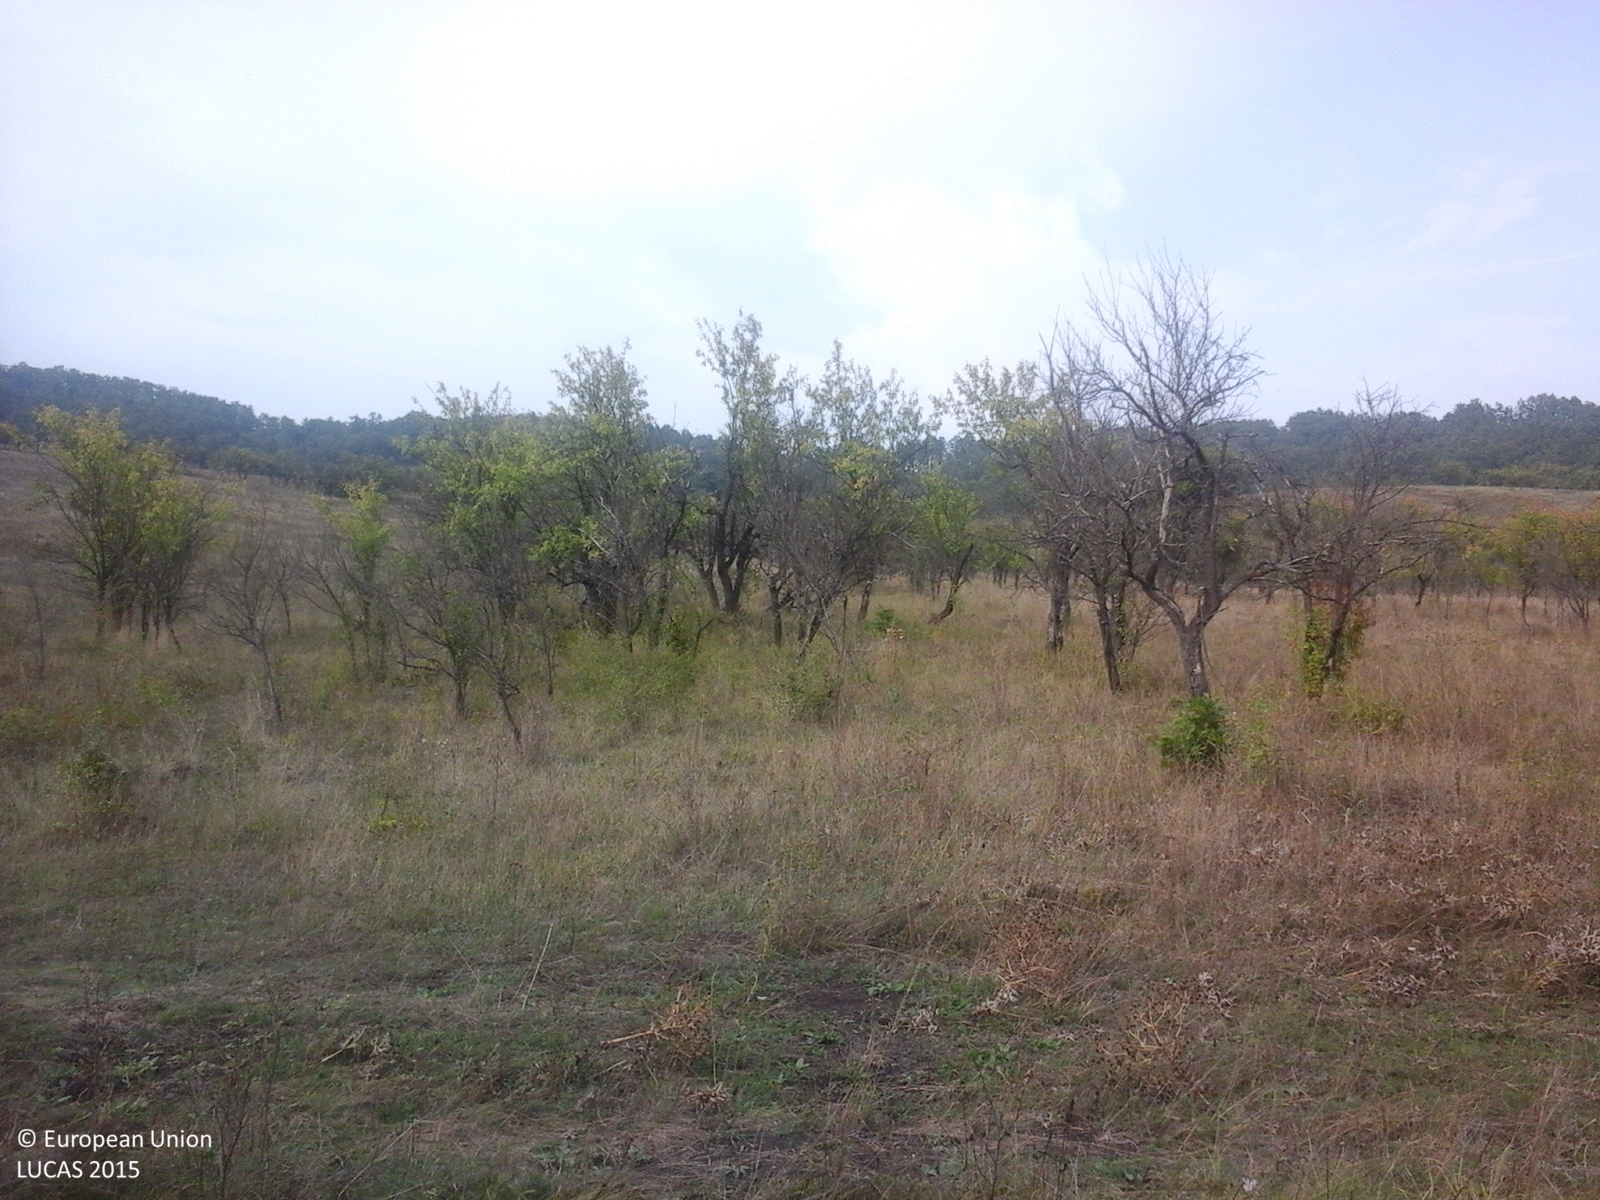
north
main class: Shrubland
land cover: Shrubland with sparse tree cover
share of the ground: > 75 %
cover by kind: shrubs 75 %, herbaceous plants 20 %, broadleaved forest trees 5 %
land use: Fallow land
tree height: > 5 m
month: September
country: RO
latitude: 45.8086
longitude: 22.8565
